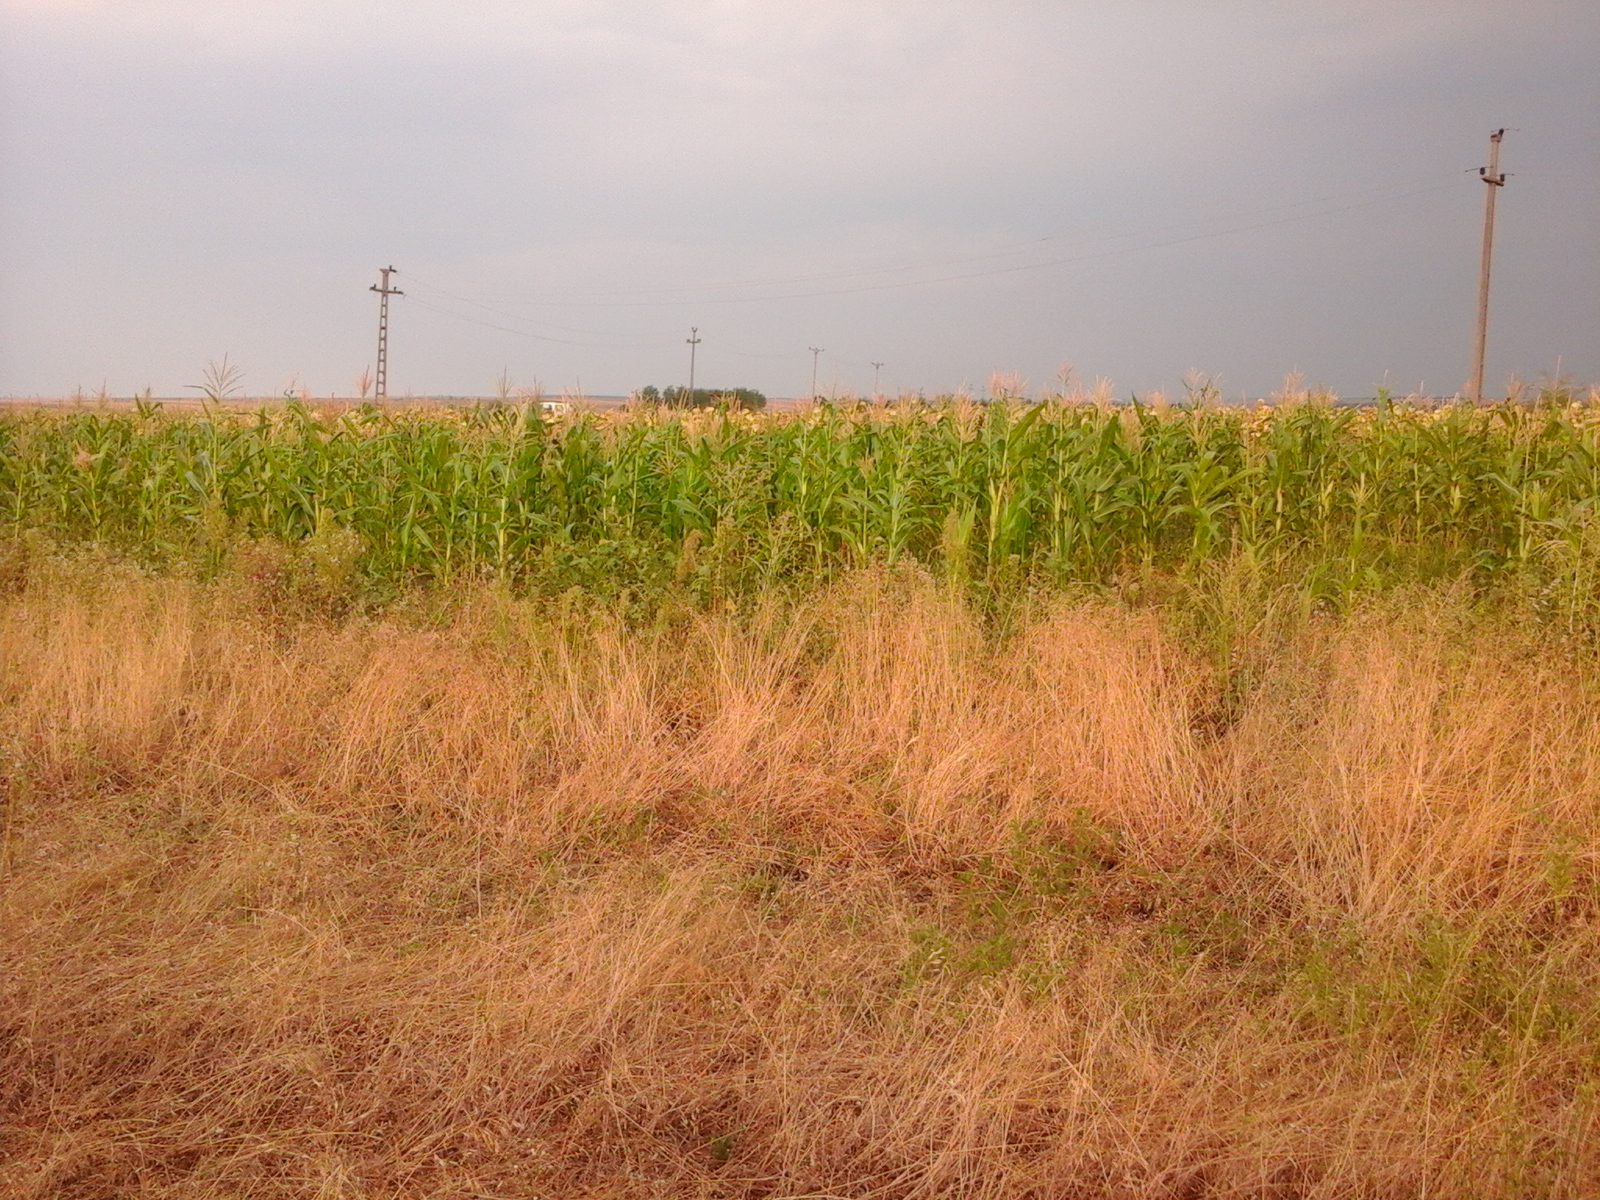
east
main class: Grassland
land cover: Grassland without tree/shrub cover
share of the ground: > 75 %
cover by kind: herbaceous plants 100 %
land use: Agriculture (excluding fallow land and kitchen gardens)
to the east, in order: Grassland without tree/shrub cover; Tracks; Grass margins; Maize; Sunflower; Electric lines; Grass margins; Tracks; Grassland without tree/shrub cover; Tracks; Grass margins; Common wheat; Grass margins; Vineyards; Grassland without tree/shrub cover
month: August
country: RO
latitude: 44.3858
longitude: 23.2919
